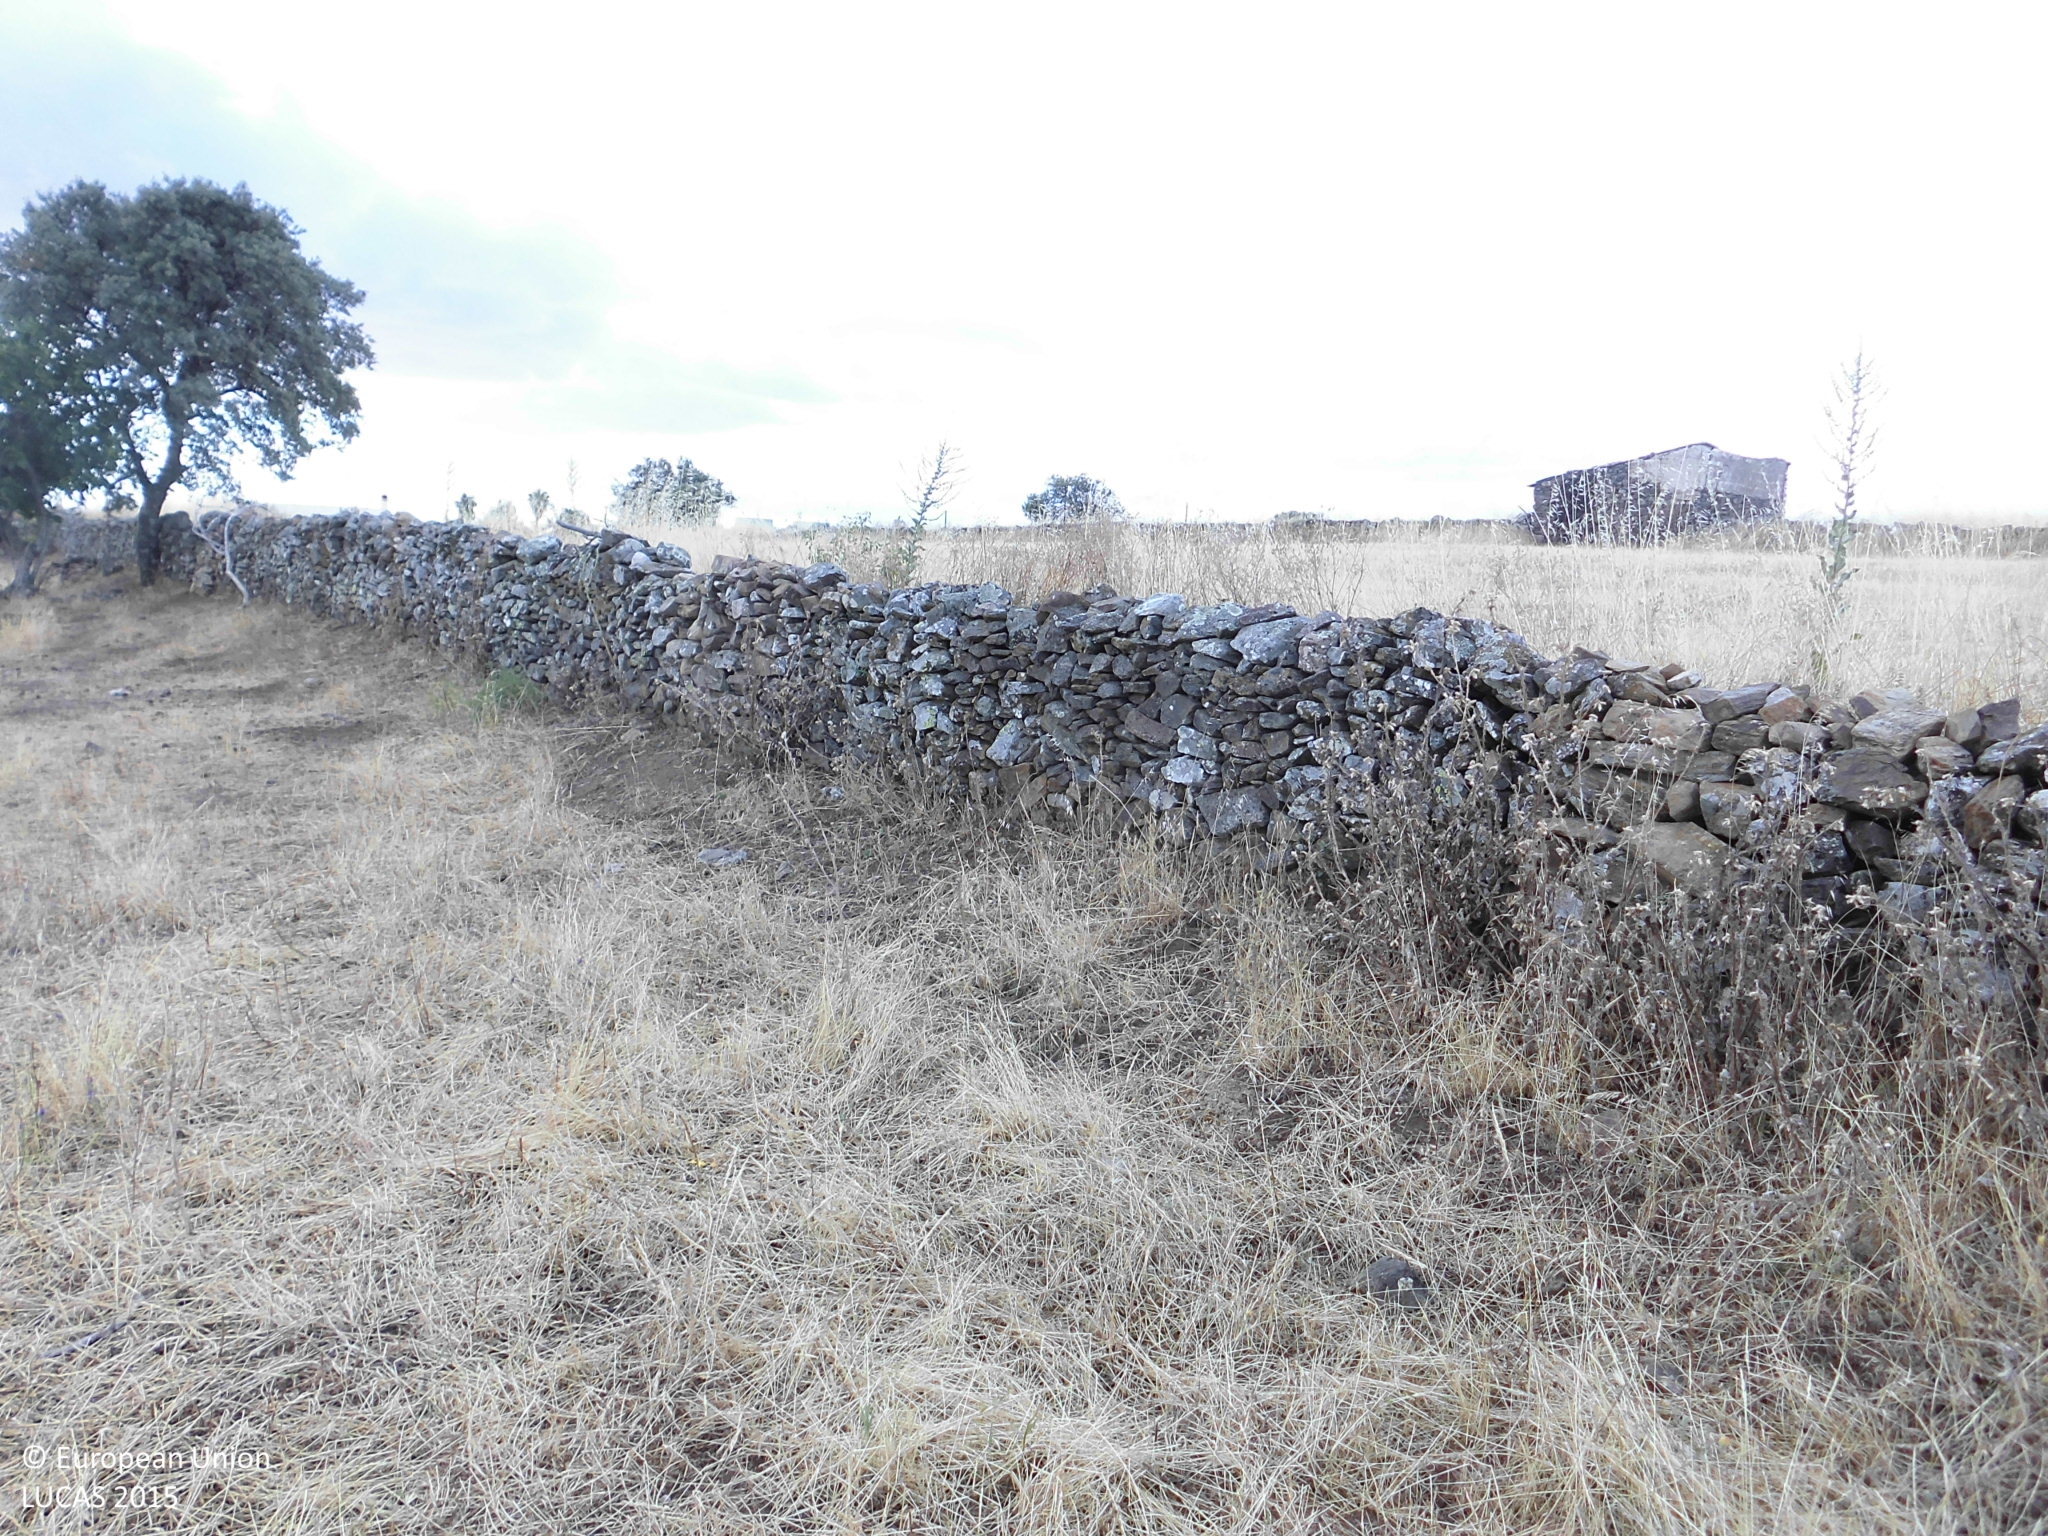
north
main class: Grassland
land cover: Grassland with sparse tree/shrub cover
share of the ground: > 75 %
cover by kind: herbaceous plants 95 %, broadleaved forest trees 5 %
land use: Agriculture (excluding fallow land and kitchen gardens)
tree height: < 5 m
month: June
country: ES
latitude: 39.3270
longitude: -5.9141
